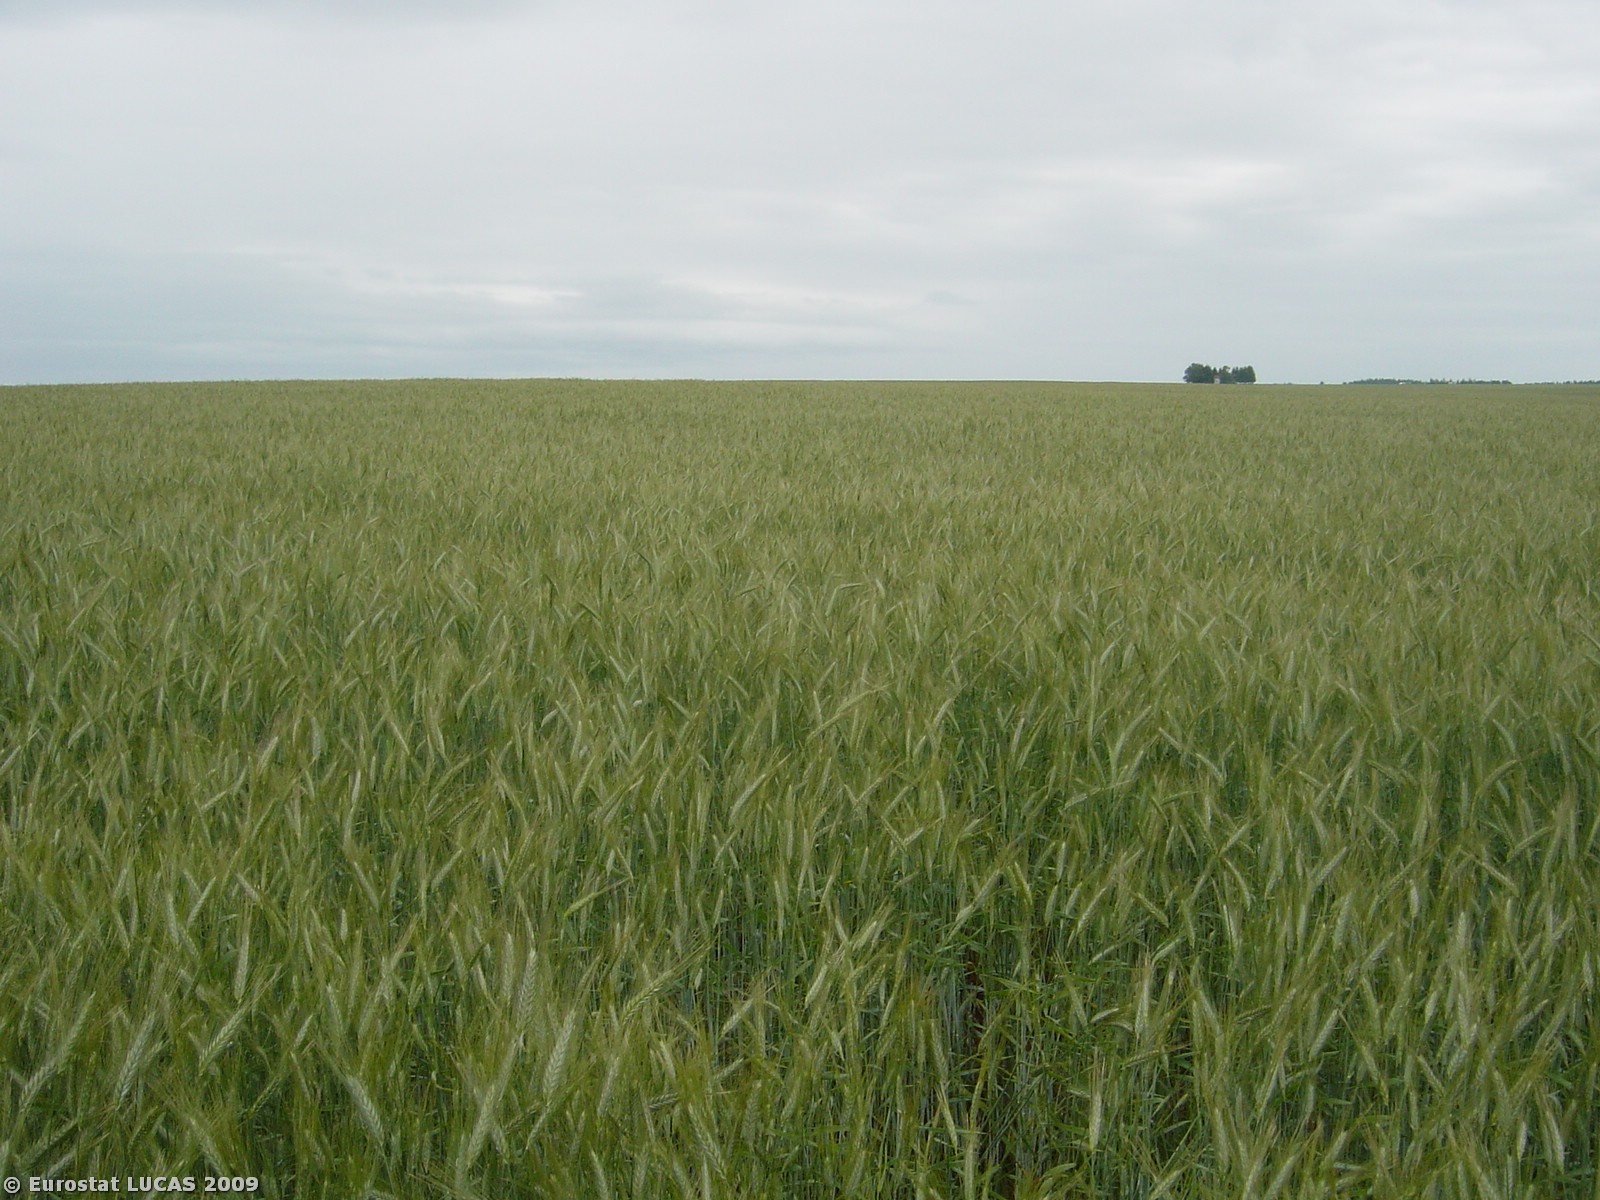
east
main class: Cropland
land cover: Triticale
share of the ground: > 75 %
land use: Agriculture (excluding fallow land and kitchen gardens)
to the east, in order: Triticale
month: June
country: CZ
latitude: 49.7631
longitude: 16.5185
